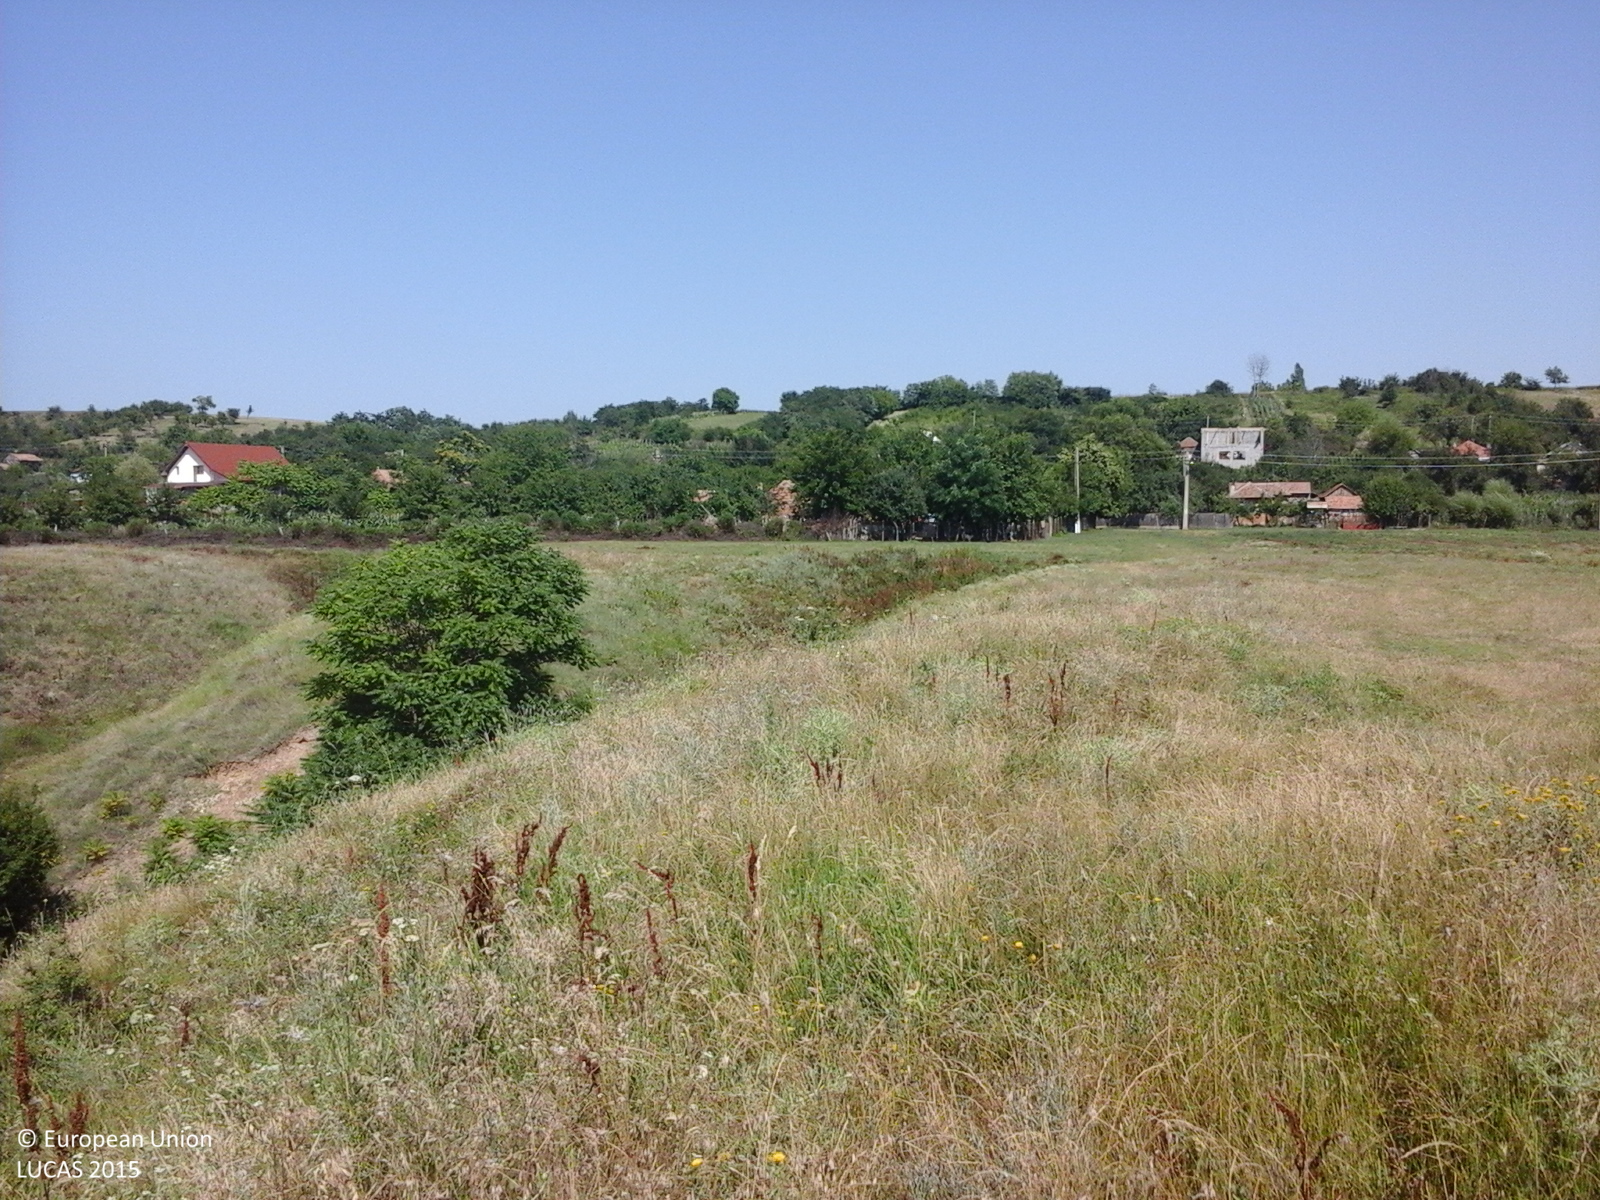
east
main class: Grassland
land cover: Grassland without tree/shrub cover
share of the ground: > 75 %
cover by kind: herbaceous plants 100 %
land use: Agriculture (excluding fallow land and kitchen gardens)
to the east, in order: Grassland without tree/shrub cover; Artificial constructions in urban areas; Maize
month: July
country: RO
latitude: 44.5747
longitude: 24.3366
